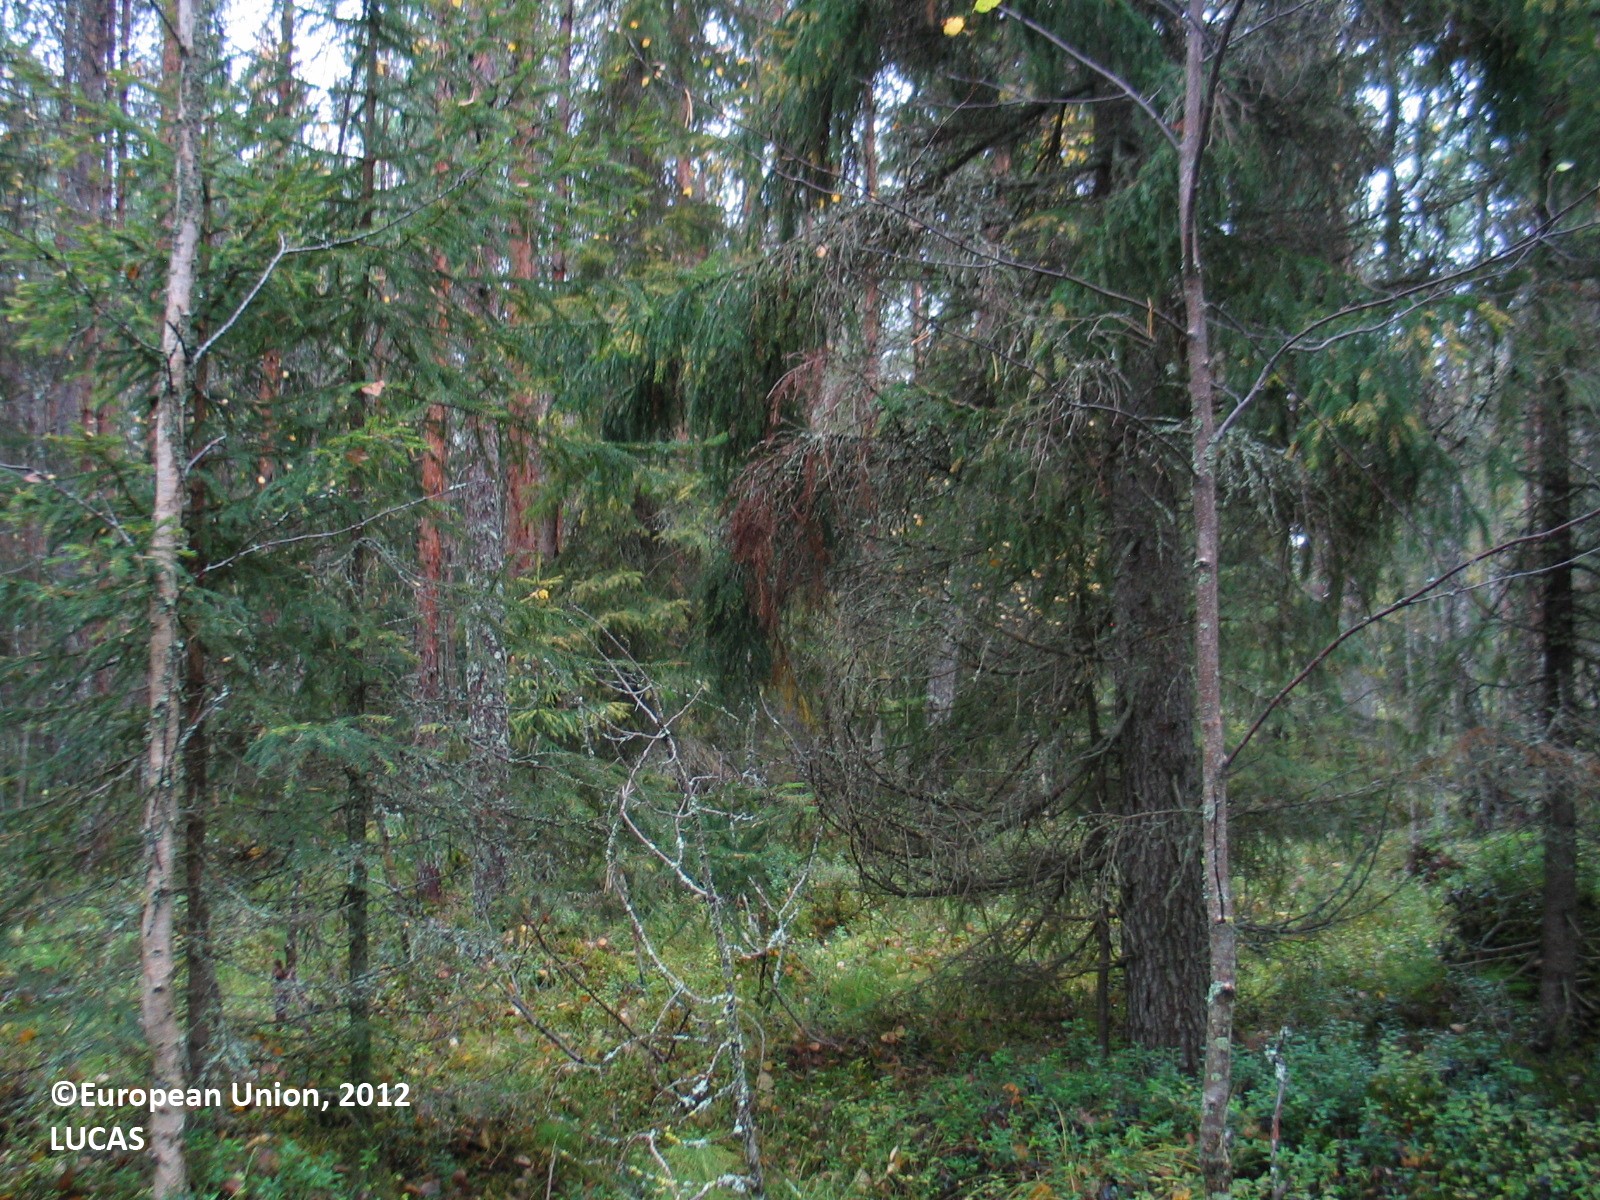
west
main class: Woodland
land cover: Pine dominated coniferous woodland
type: mire and swamp forests
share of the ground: 50 - 75 %
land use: Forestry
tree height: > 5 m
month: September
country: FI
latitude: 65.3824
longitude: 25.5490
